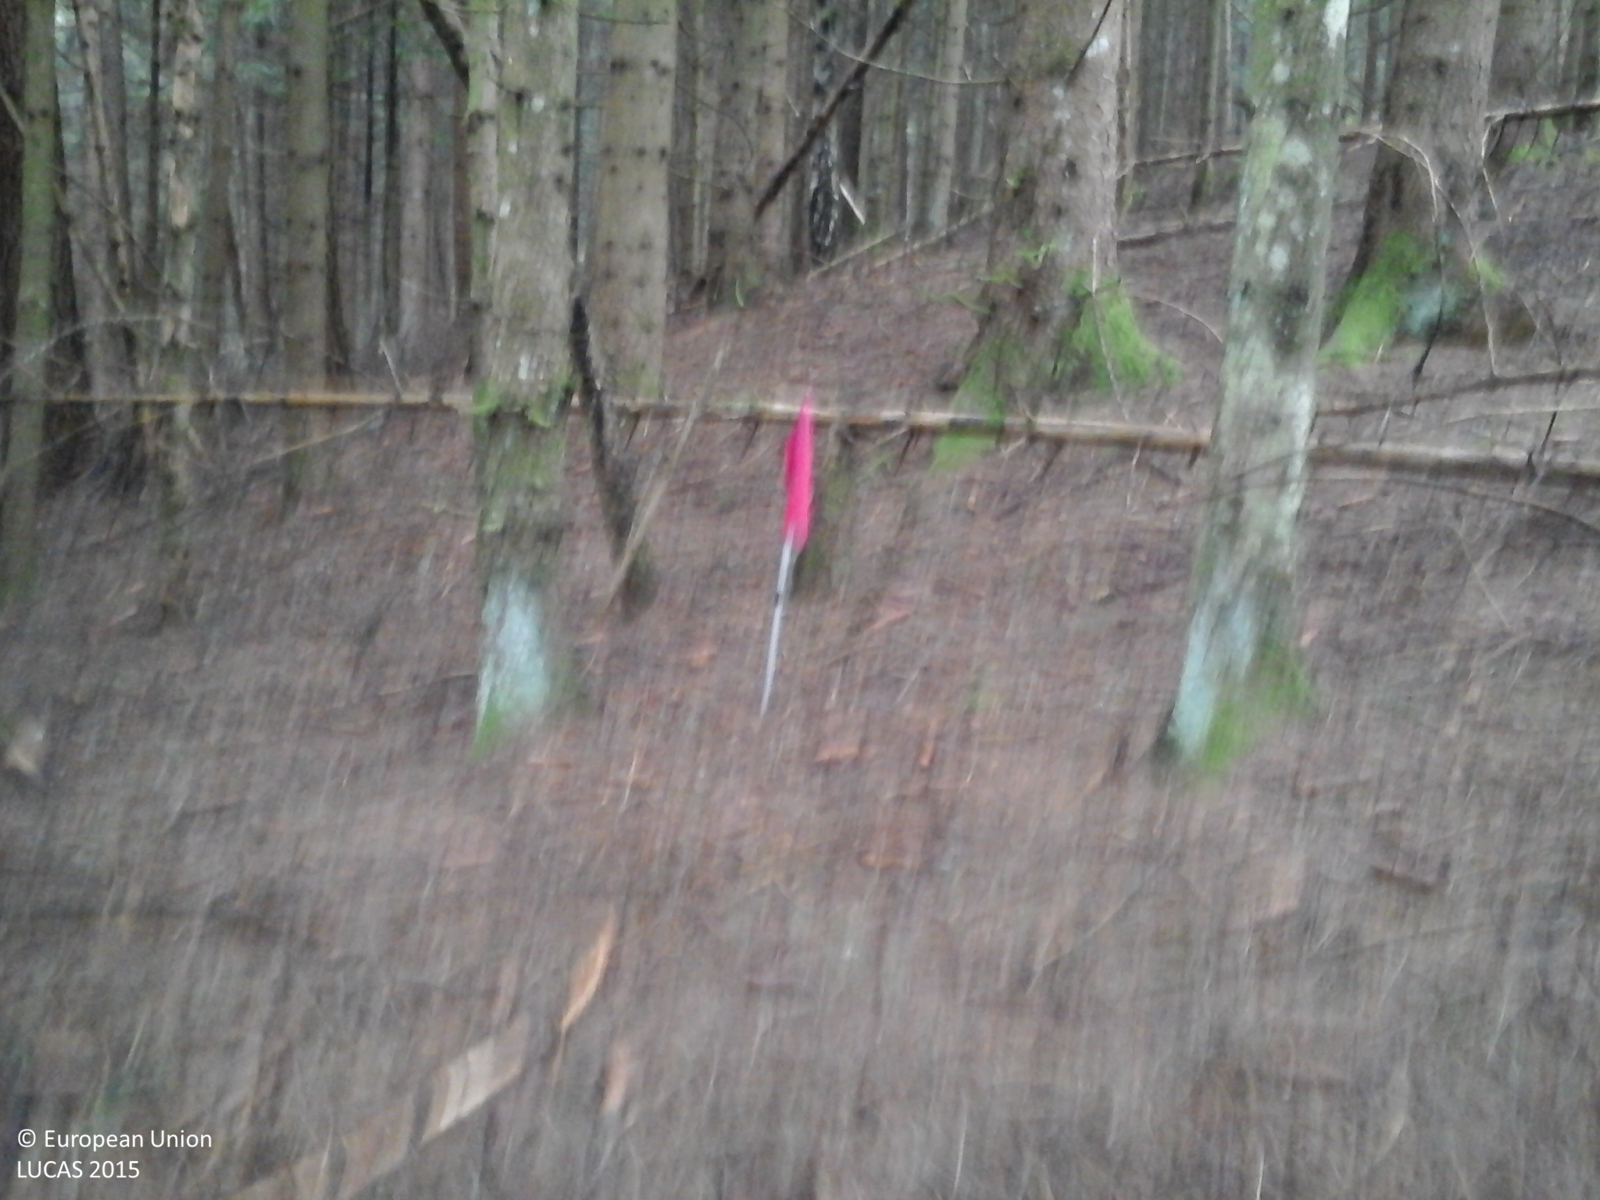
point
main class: Woodland
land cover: Spruce dominated coniferous woodland
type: alpine coniferous forest
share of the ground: > 75 %
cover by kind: coniferous forest trees 100 %
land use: Forestry
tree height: > 5 m
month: May
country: IT
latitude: 46.0328
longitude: 11.6128
